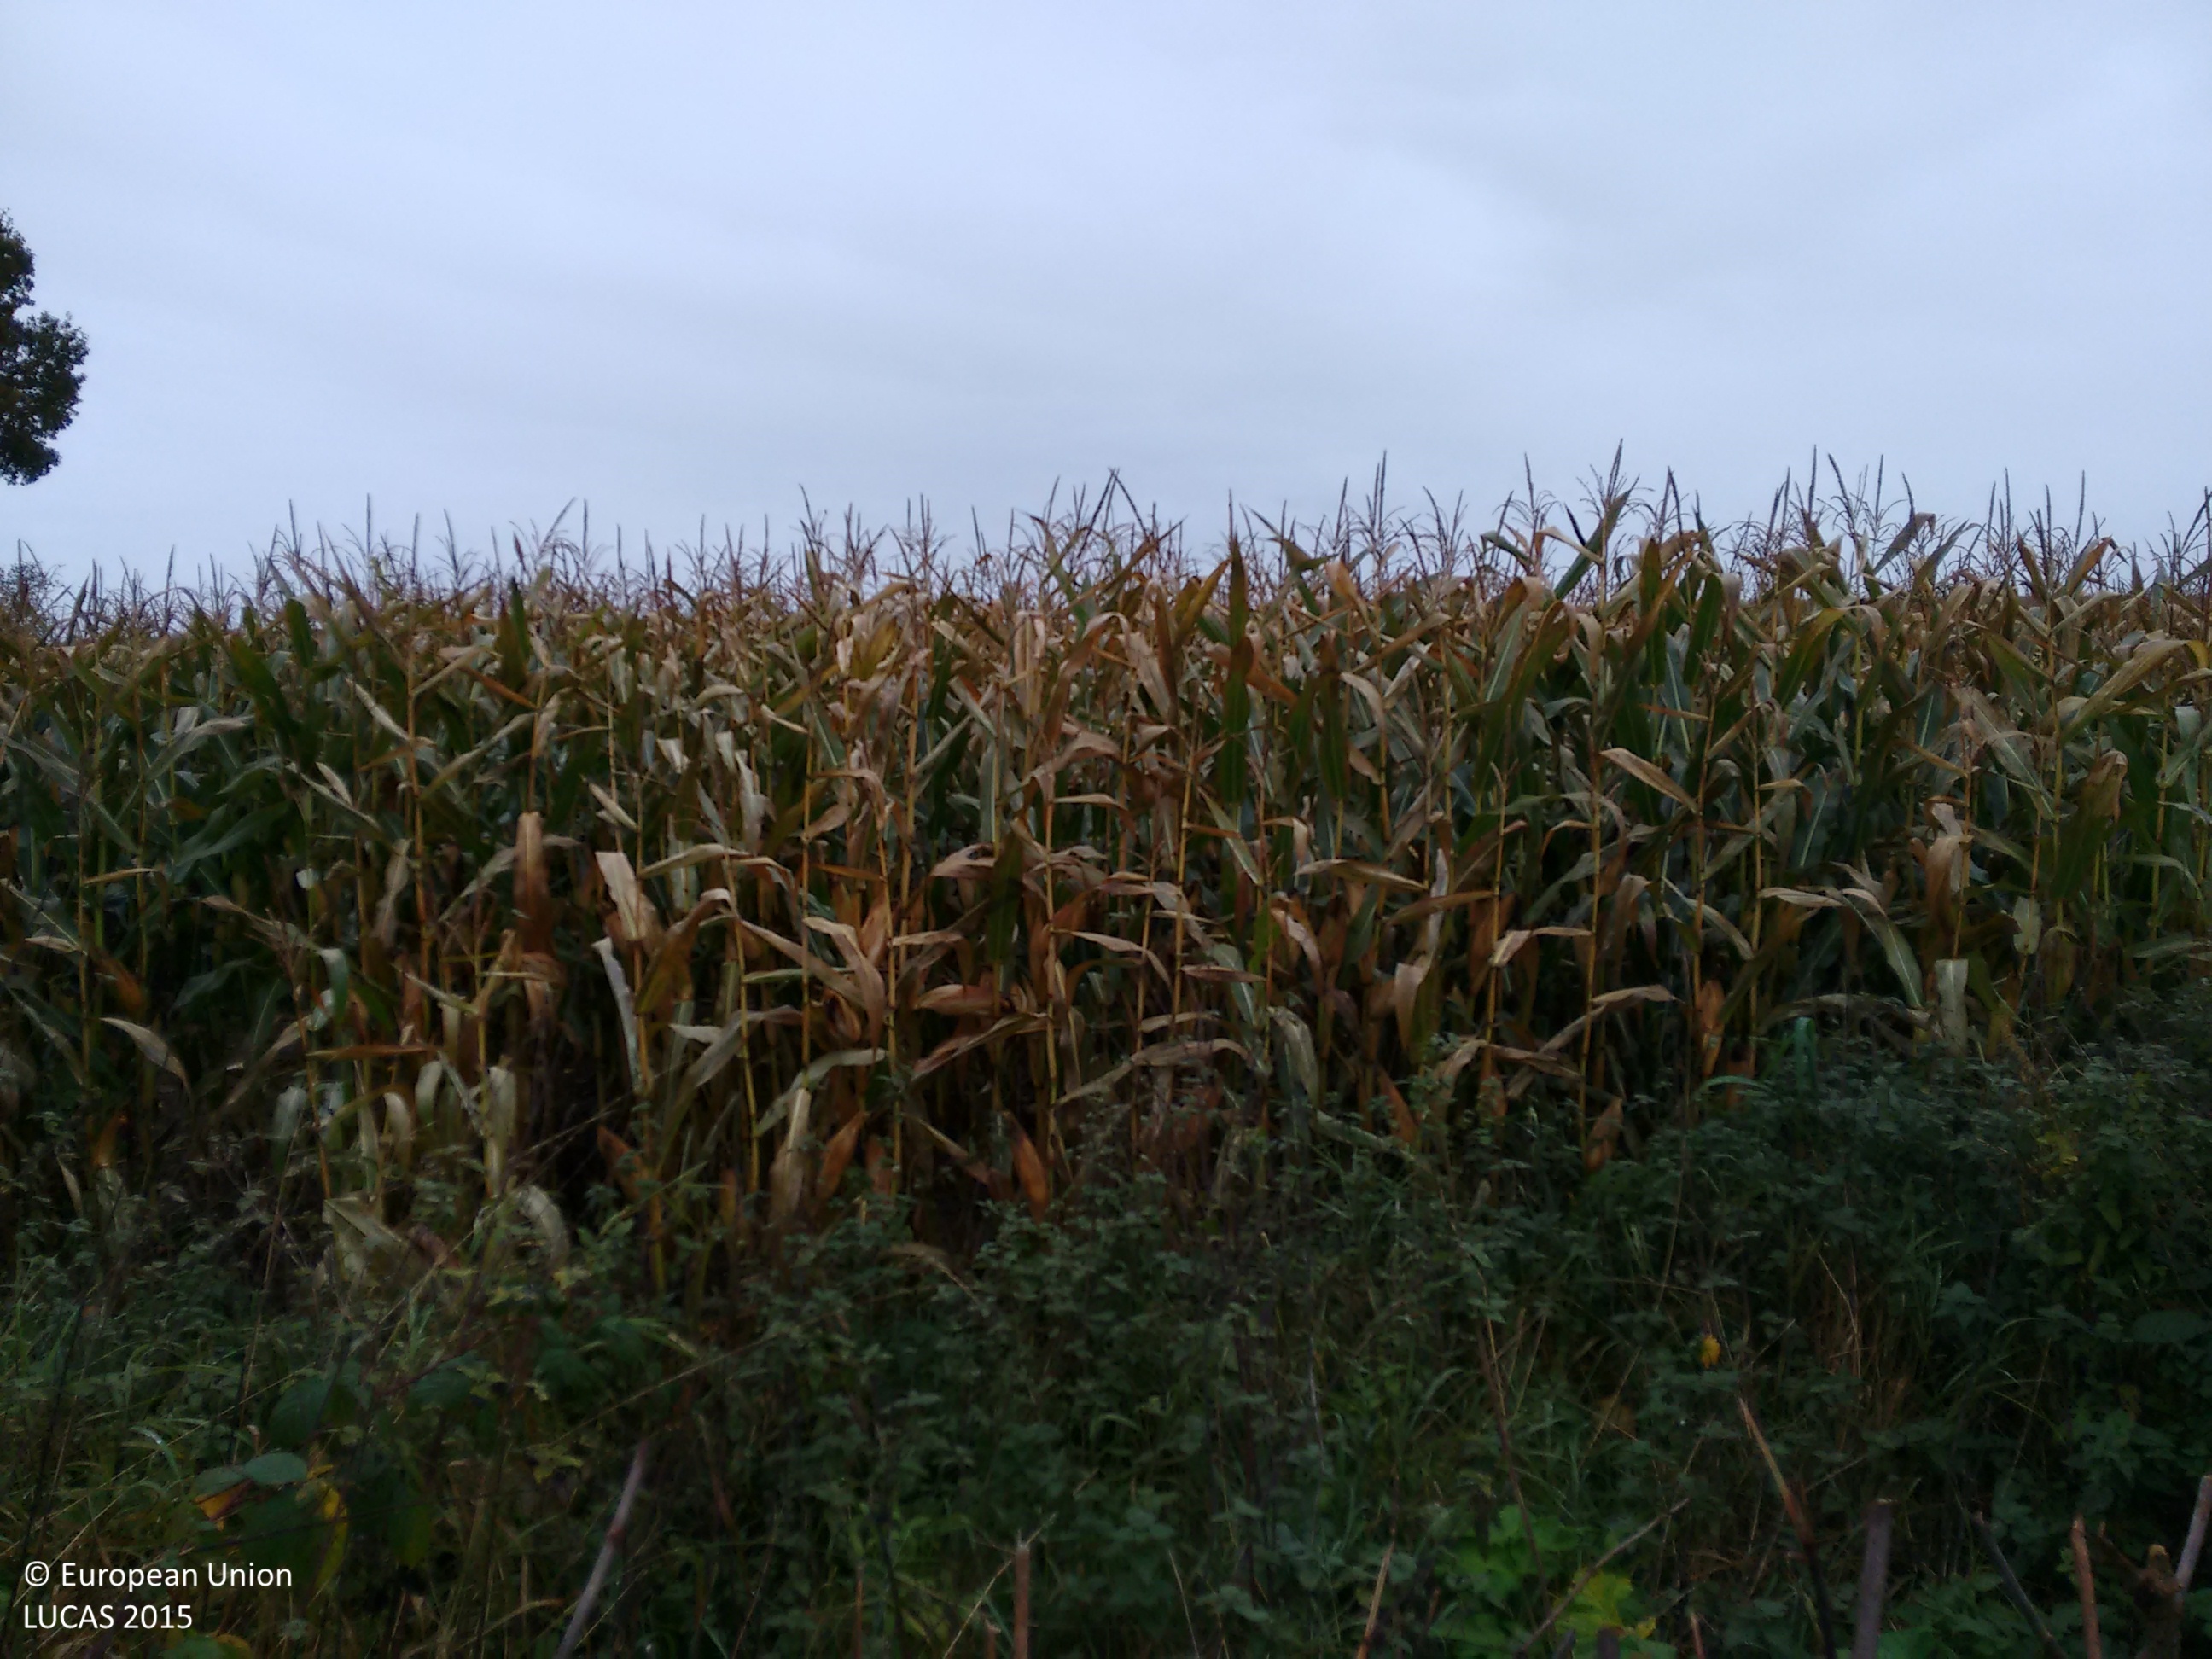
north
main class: Cropland
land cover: Maize
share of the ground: > 75 %
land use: Agriculture (excluding fallow land and kitchen gardens)
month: October
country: GB
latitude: 52.3849
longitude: -2.6903
